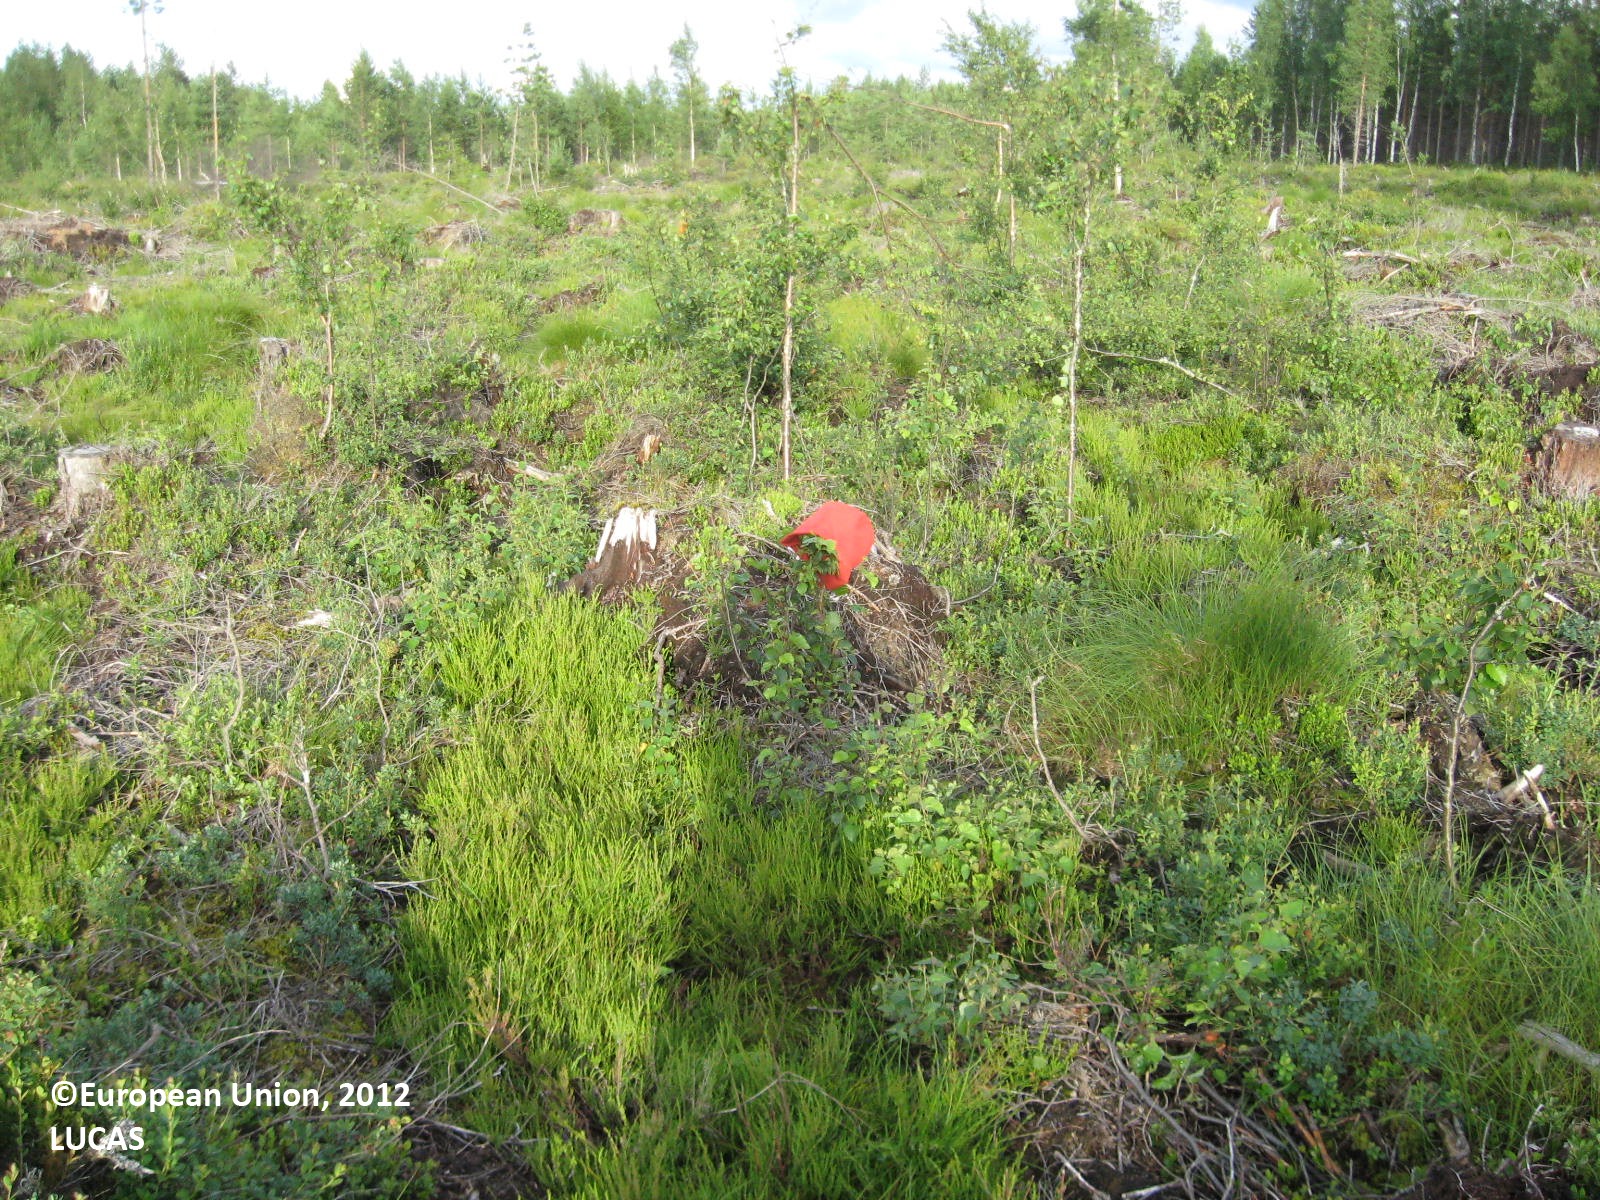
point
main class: Grassland
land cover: Grassland with sparse tree/shrub cover
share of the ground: 50 - 75 %
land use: Forestry
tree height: < 5 m
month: July
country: FI
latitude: 62.3713
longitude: 22.4069
